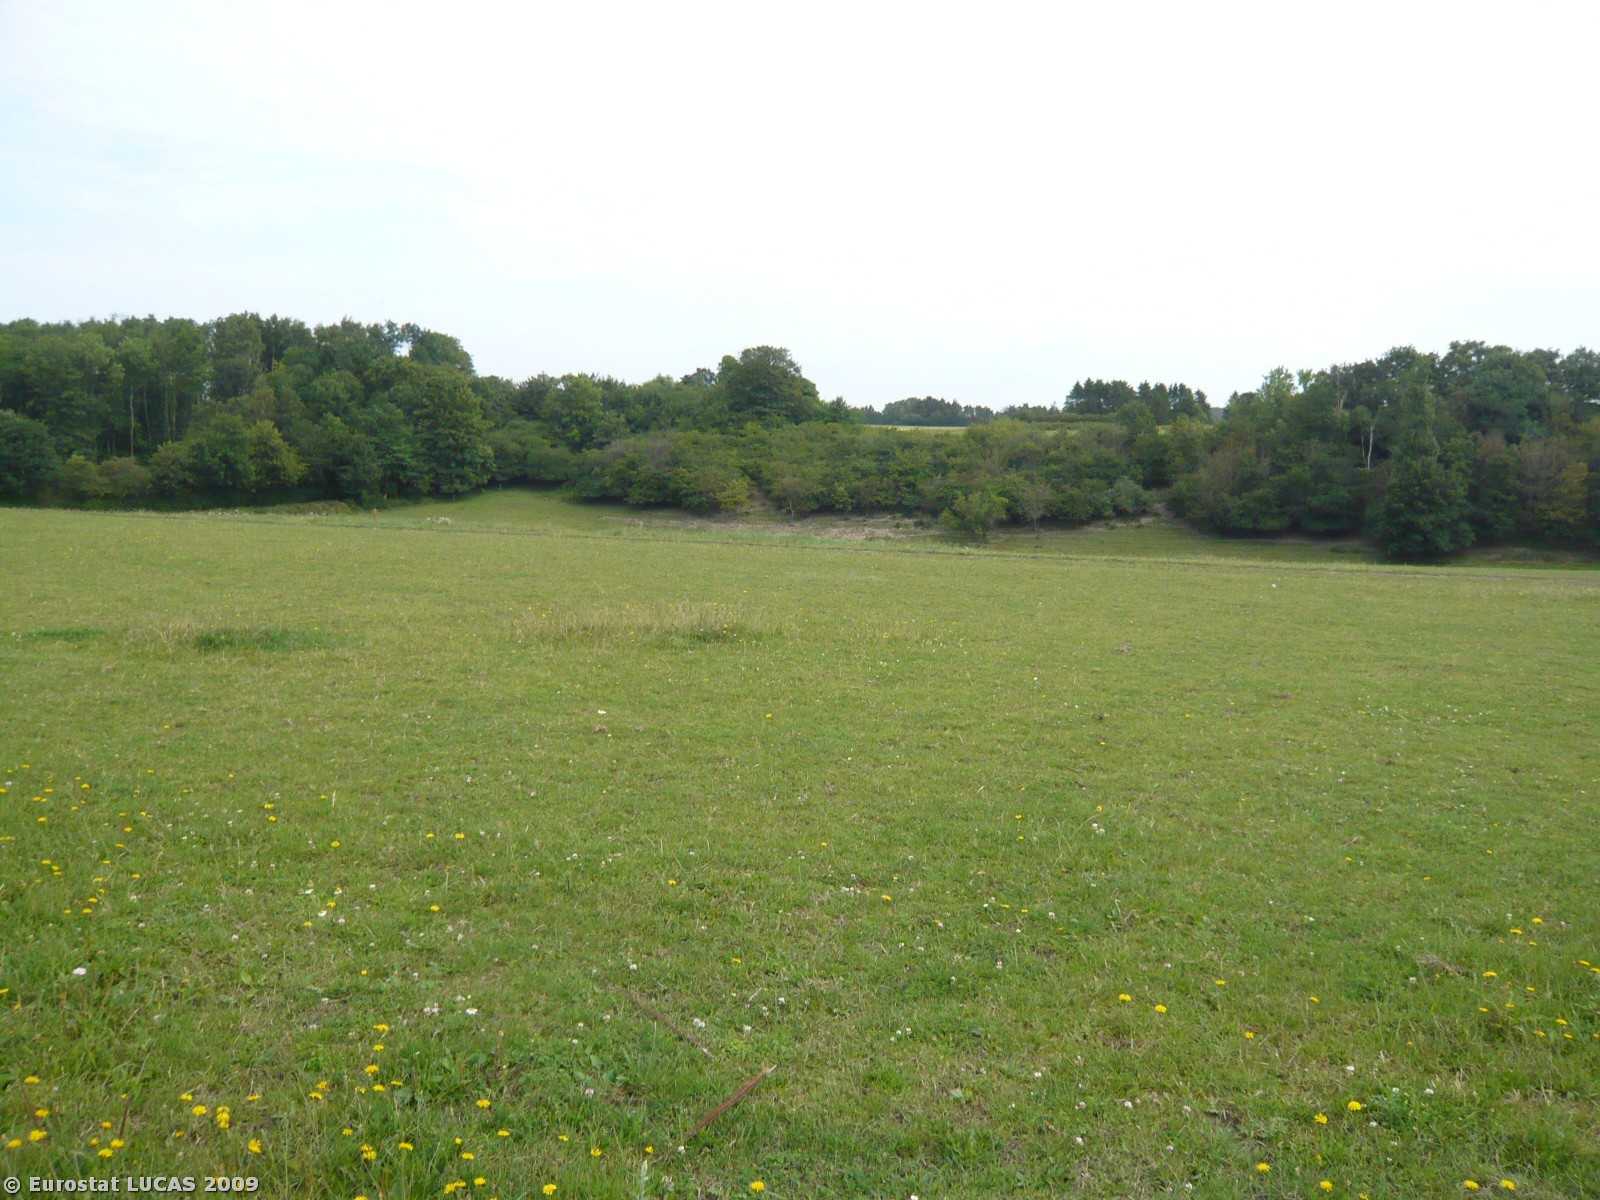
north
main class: Grassland
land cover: Grassland without tree/shrub cover
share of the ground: > 75 %
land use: Agriculture (excluding fallow land and kitchen gardens)
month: July
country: DK
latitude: 55.8095
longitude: 12.1841
